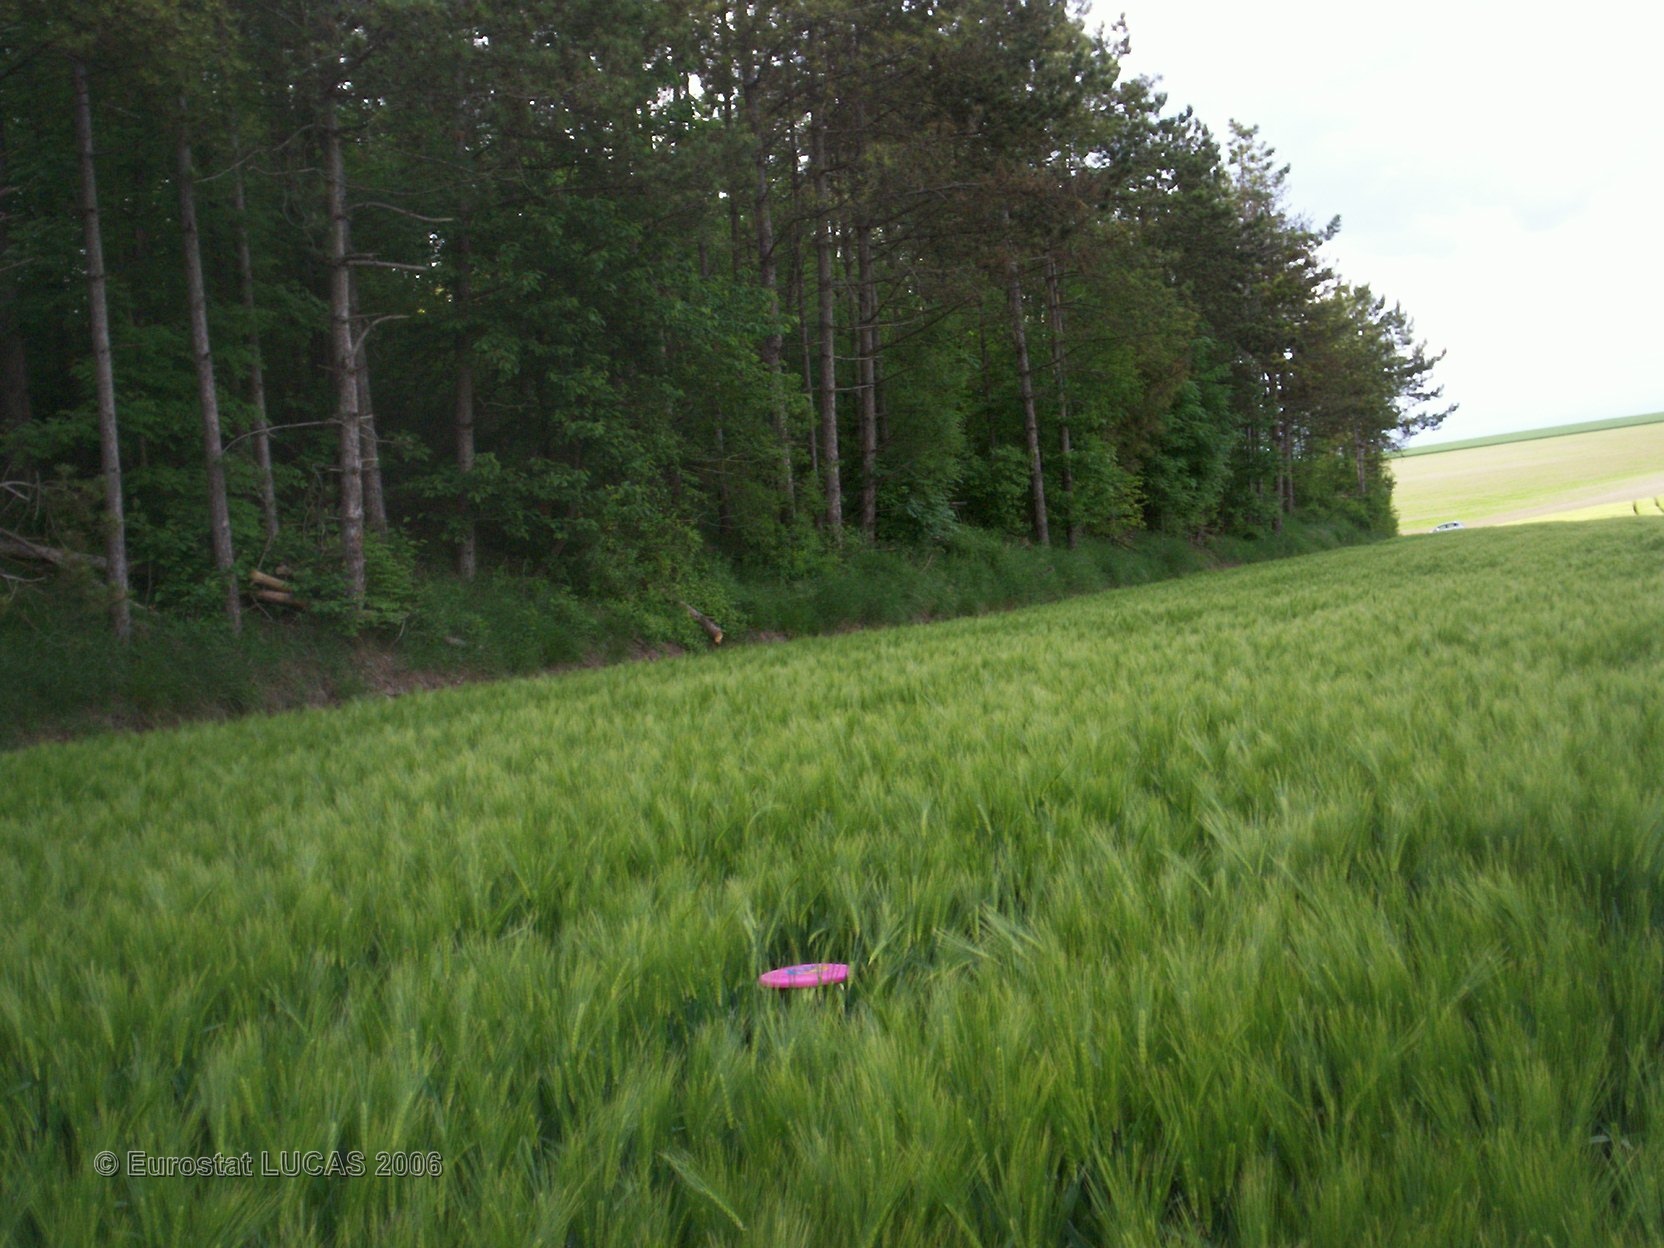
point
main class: Cropland
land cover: Barley
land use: Agriculture (excluding fallow land and kitchen gardens)
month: May
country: FR
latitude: 49.4688
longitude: 4.3797
